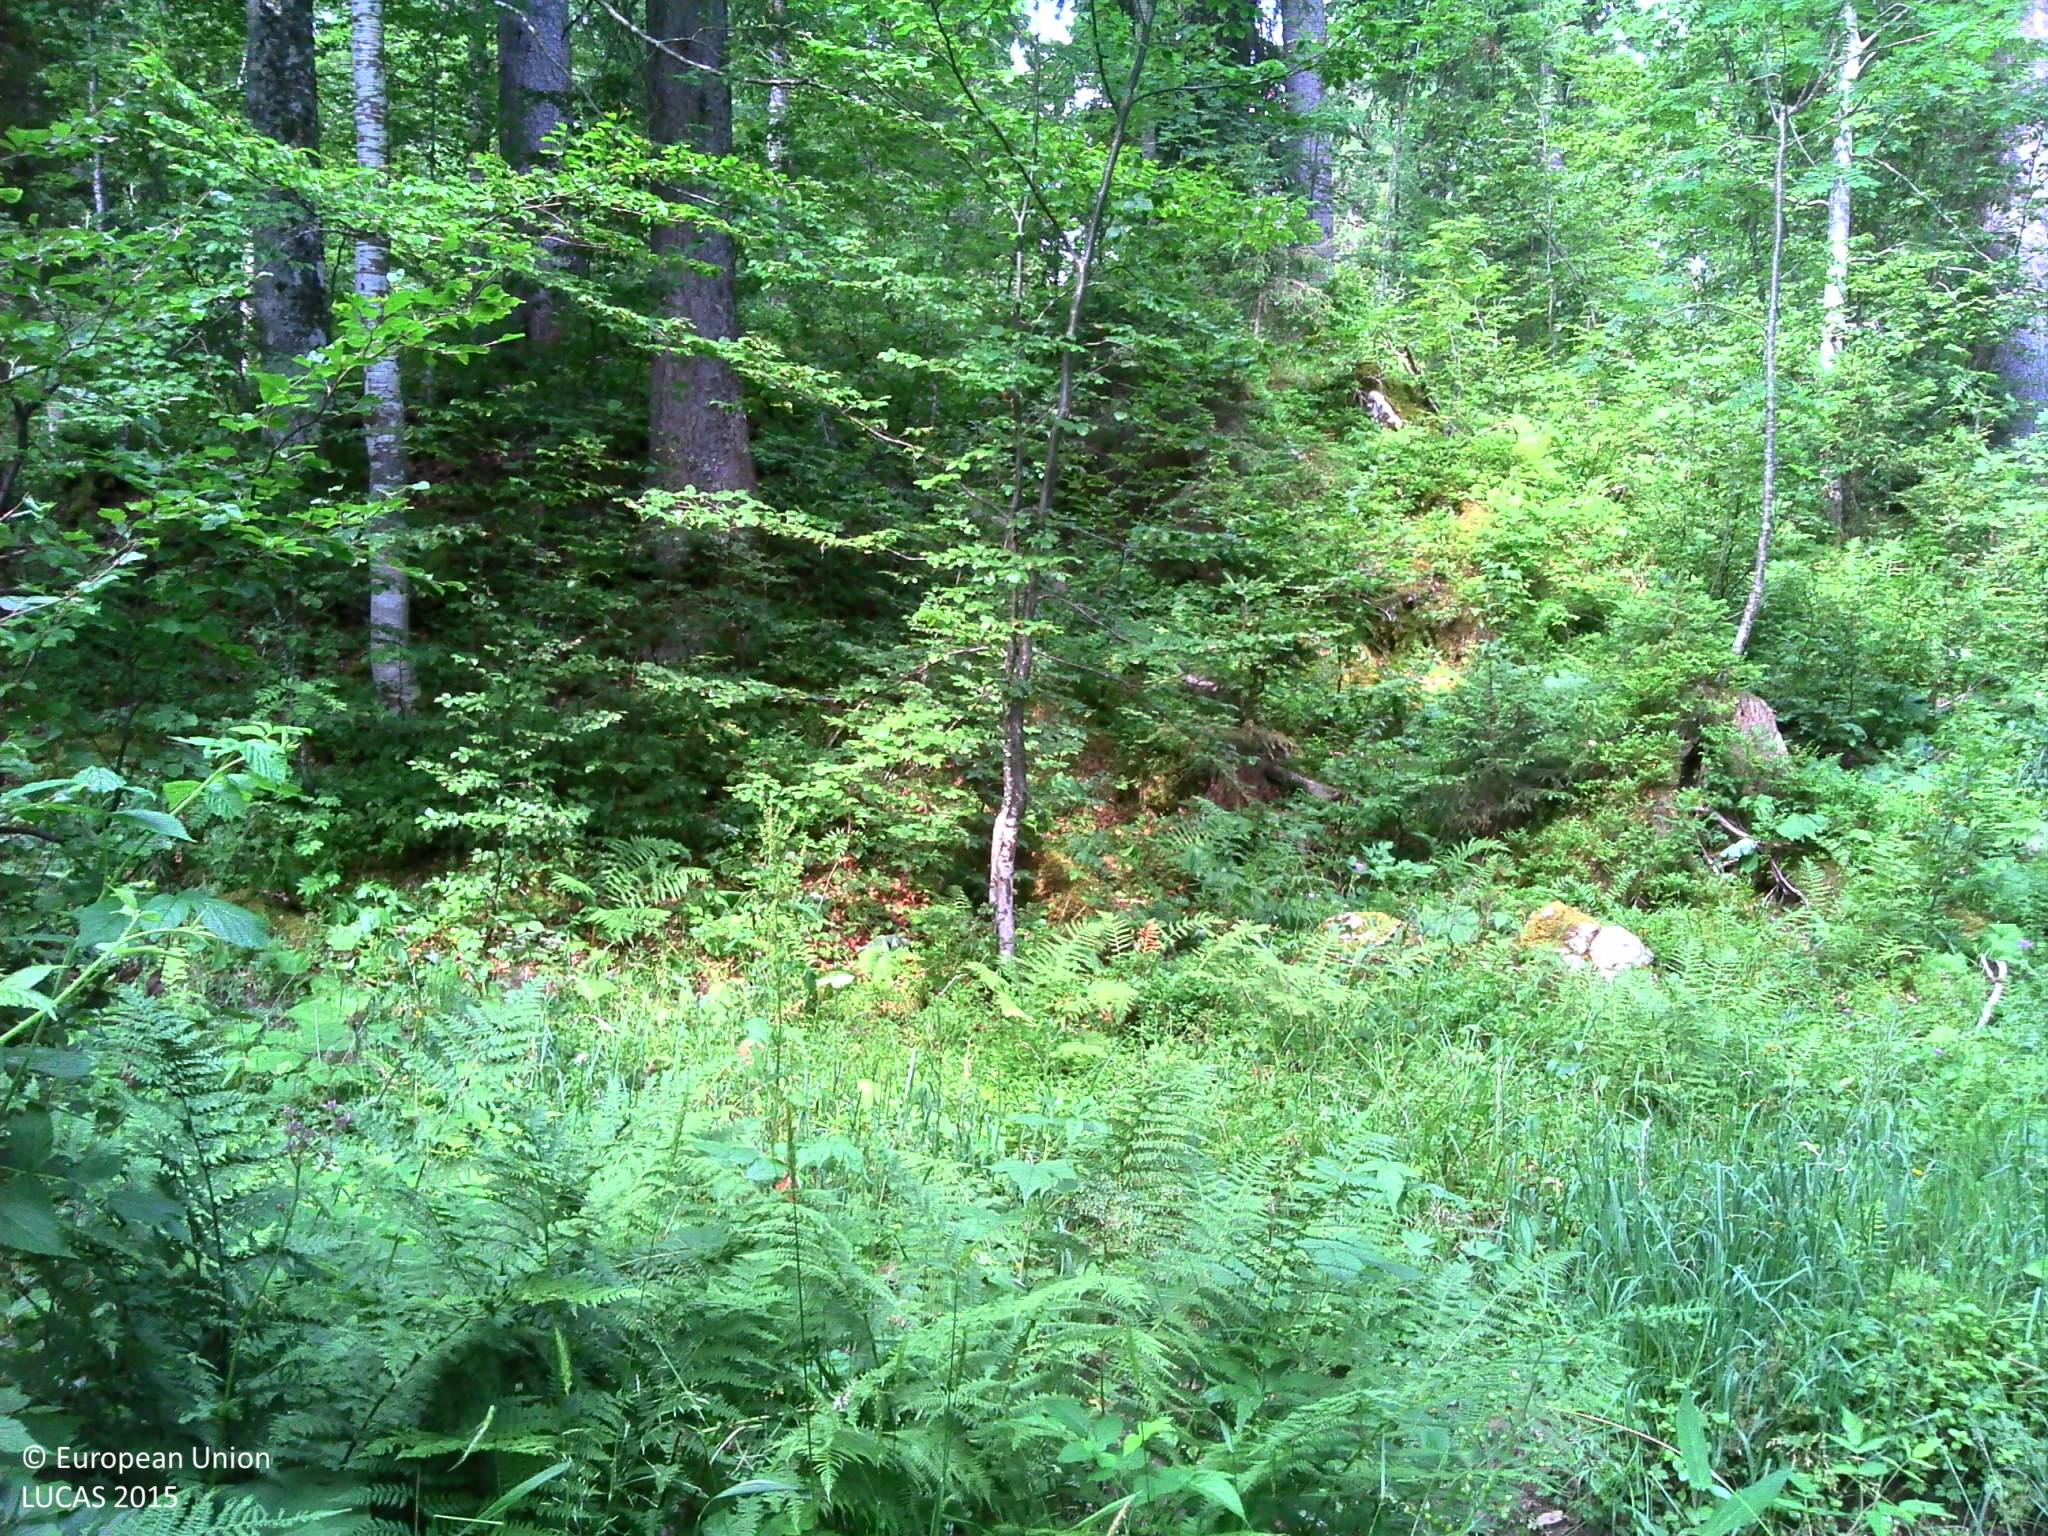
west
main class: Woodland
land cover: Spruce dominated mixed woodland
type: mountainous beech forest
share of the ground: 50 - 75 %
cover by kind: herbaceous plants 35 %, consolidated bare surface 20 %, coniferous forest trees 15 %, broadleaved forest trees 15 %, lichens and mosses 10 %, shrubs 5 %
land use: Forestry
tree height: > 5 m
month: July
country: FR
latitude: 46.5138
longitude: 6.0798
